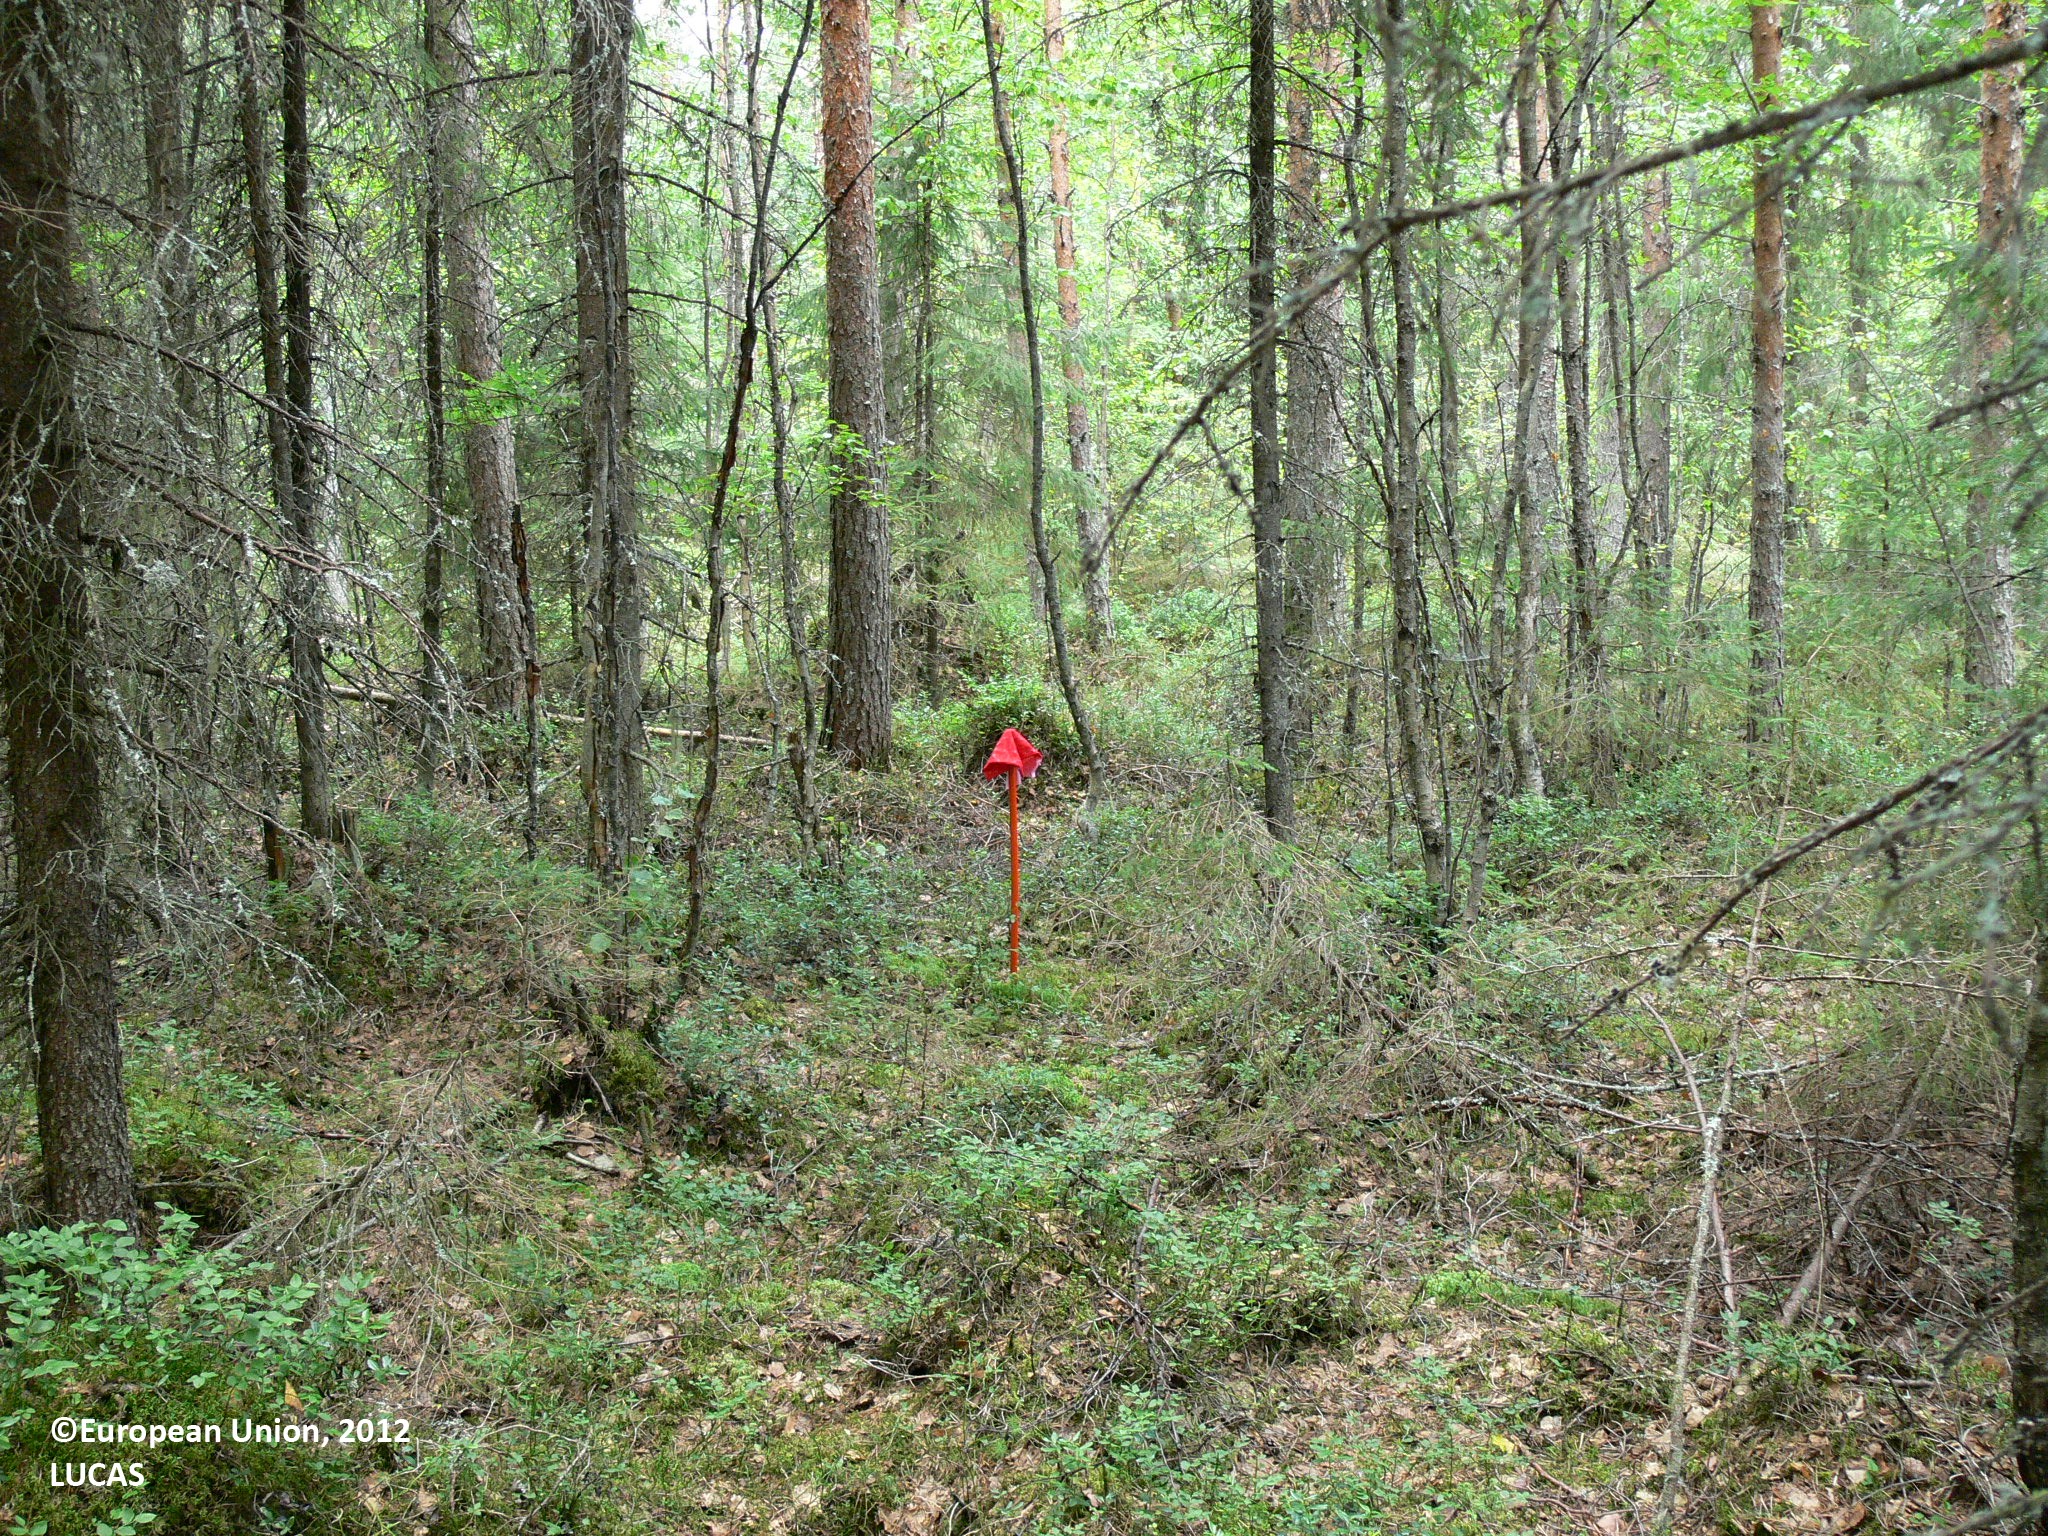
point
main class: Woodland
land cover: Other coniferous woodland
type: boreal forest
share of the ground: > 75 %
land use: Forestry
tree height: > 5 m
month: August
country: FI
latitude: 62.0420
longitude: 29.3791
